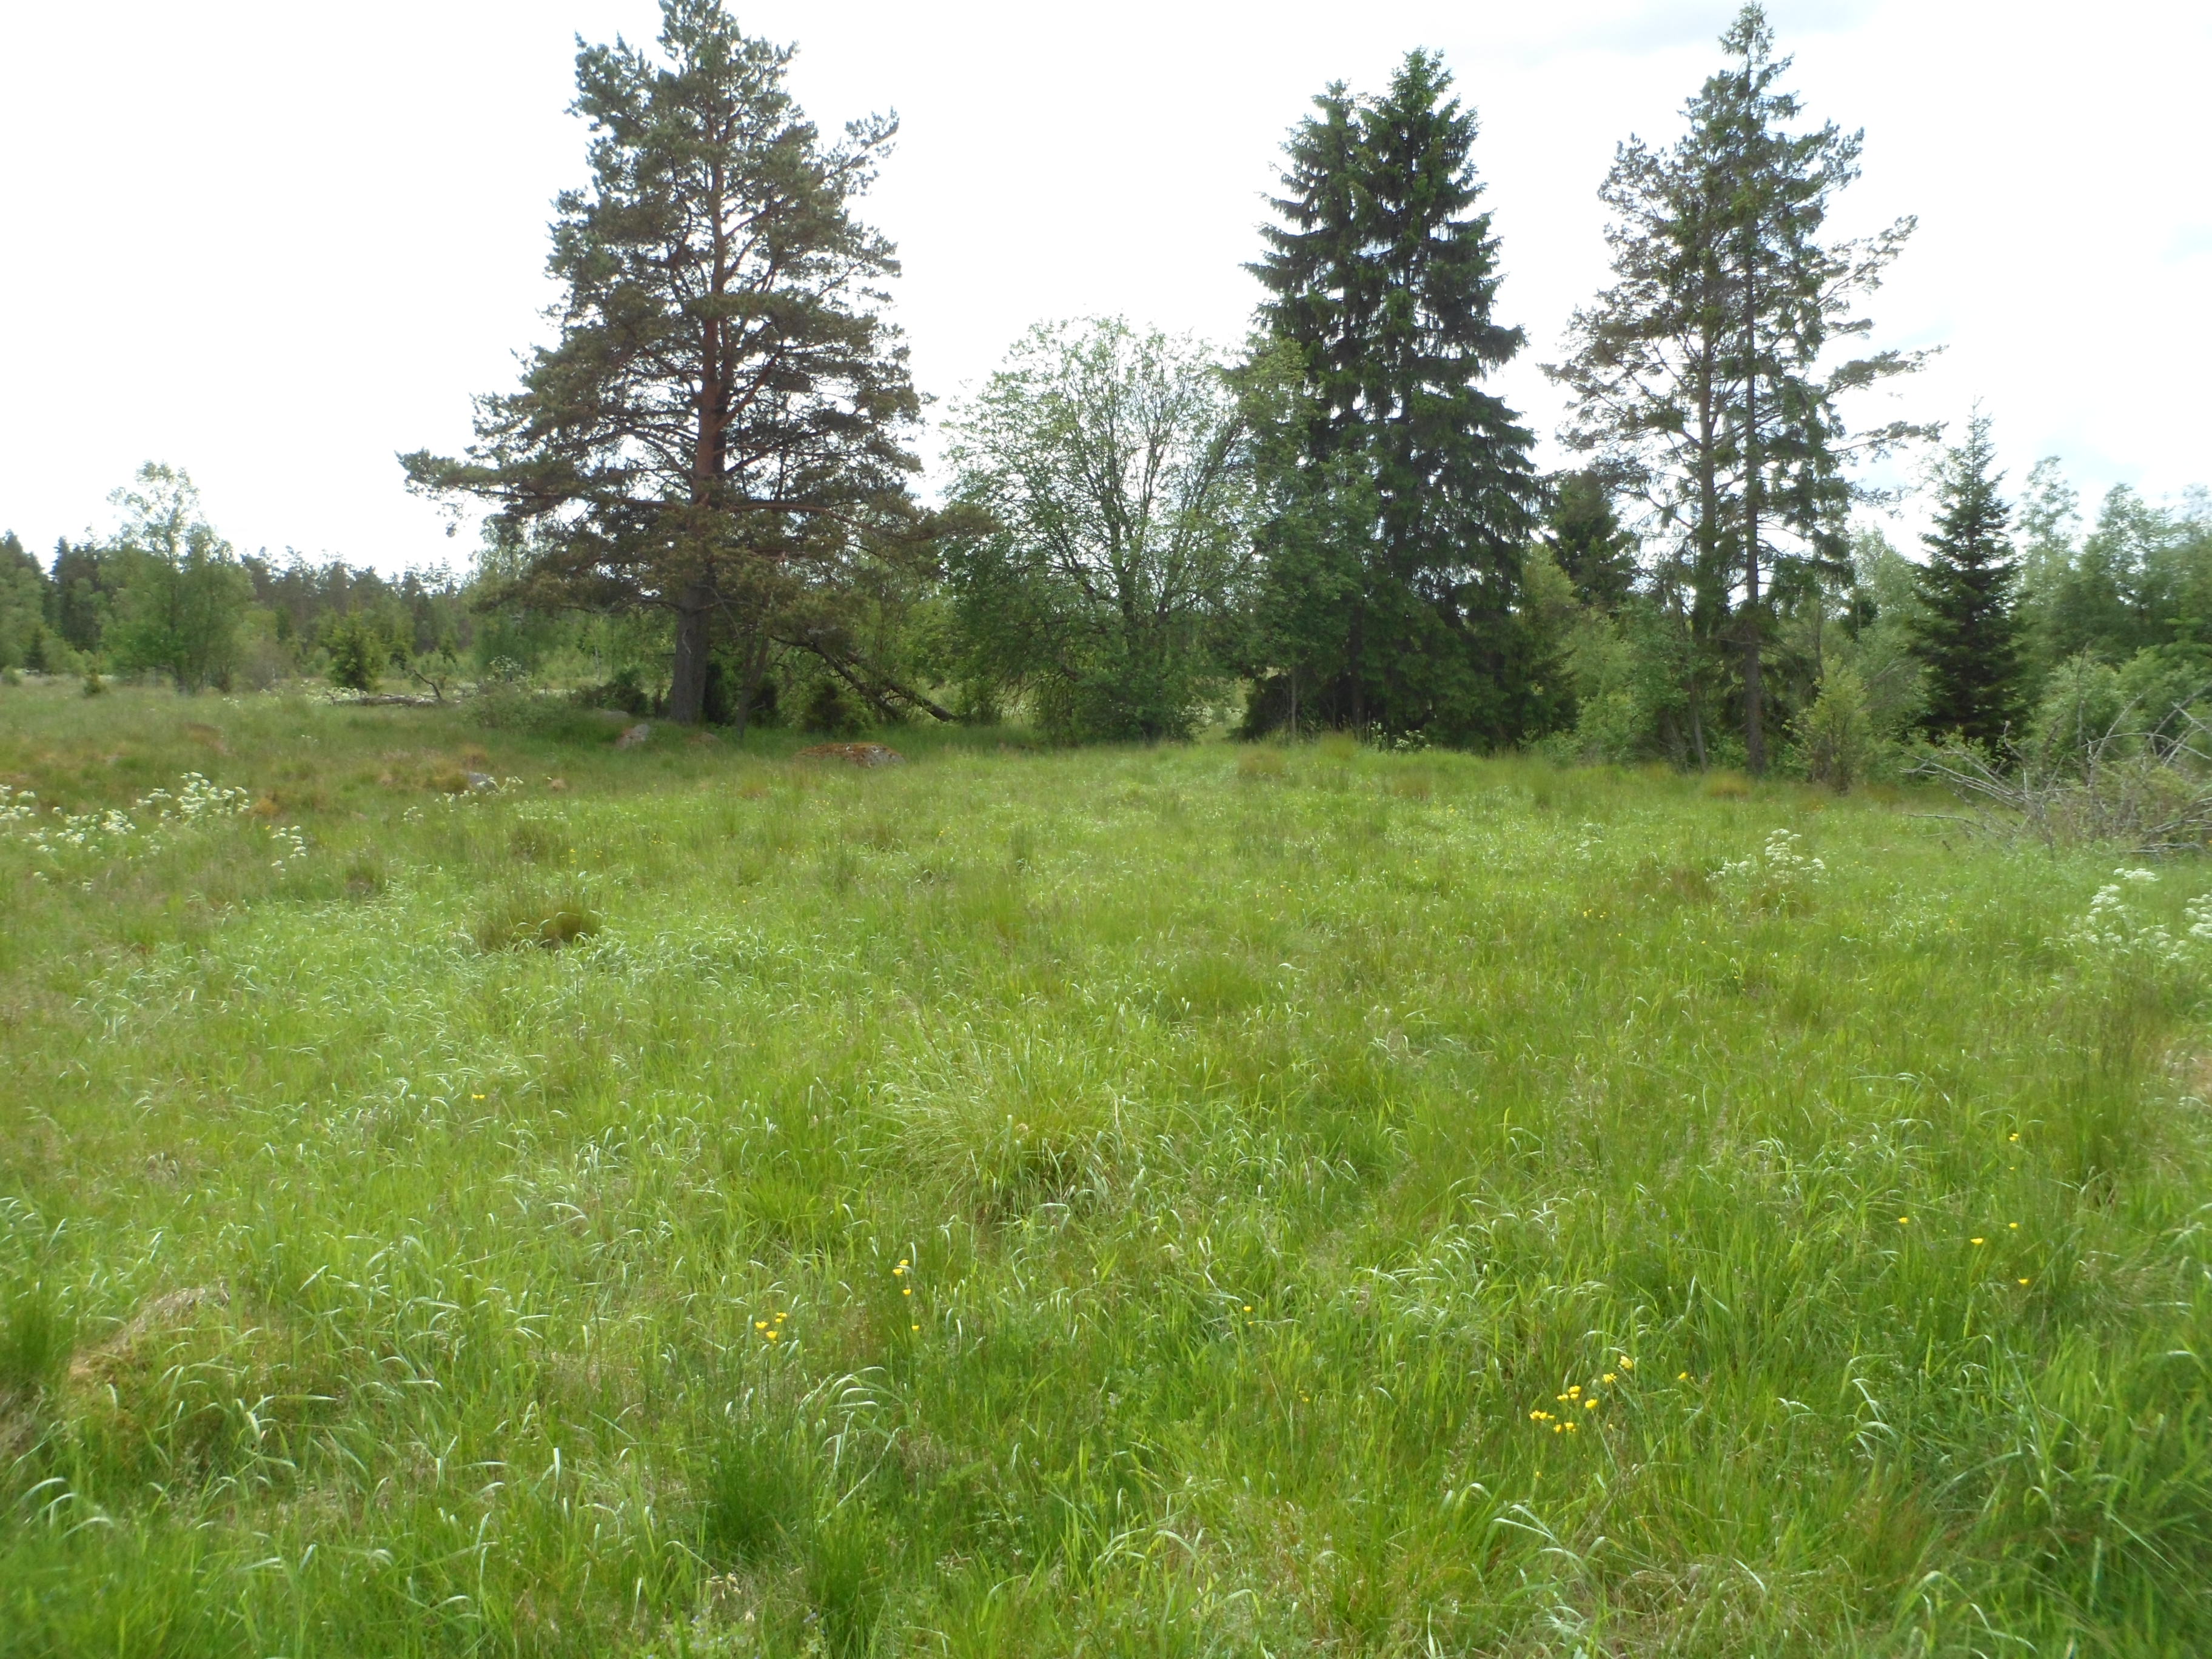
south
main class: Grassland
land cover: Grassland with sparse tree/shrub cover
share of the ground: > 75 %
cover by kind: herbaceous plants 90 %, broadleaved forest trees 5 %, shrubs 5 %
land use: Agriculture (excluding fallow land and kitchen gardens)
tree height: < 5 m
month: June
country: SE
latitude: 57.3086
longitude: 14.1626
